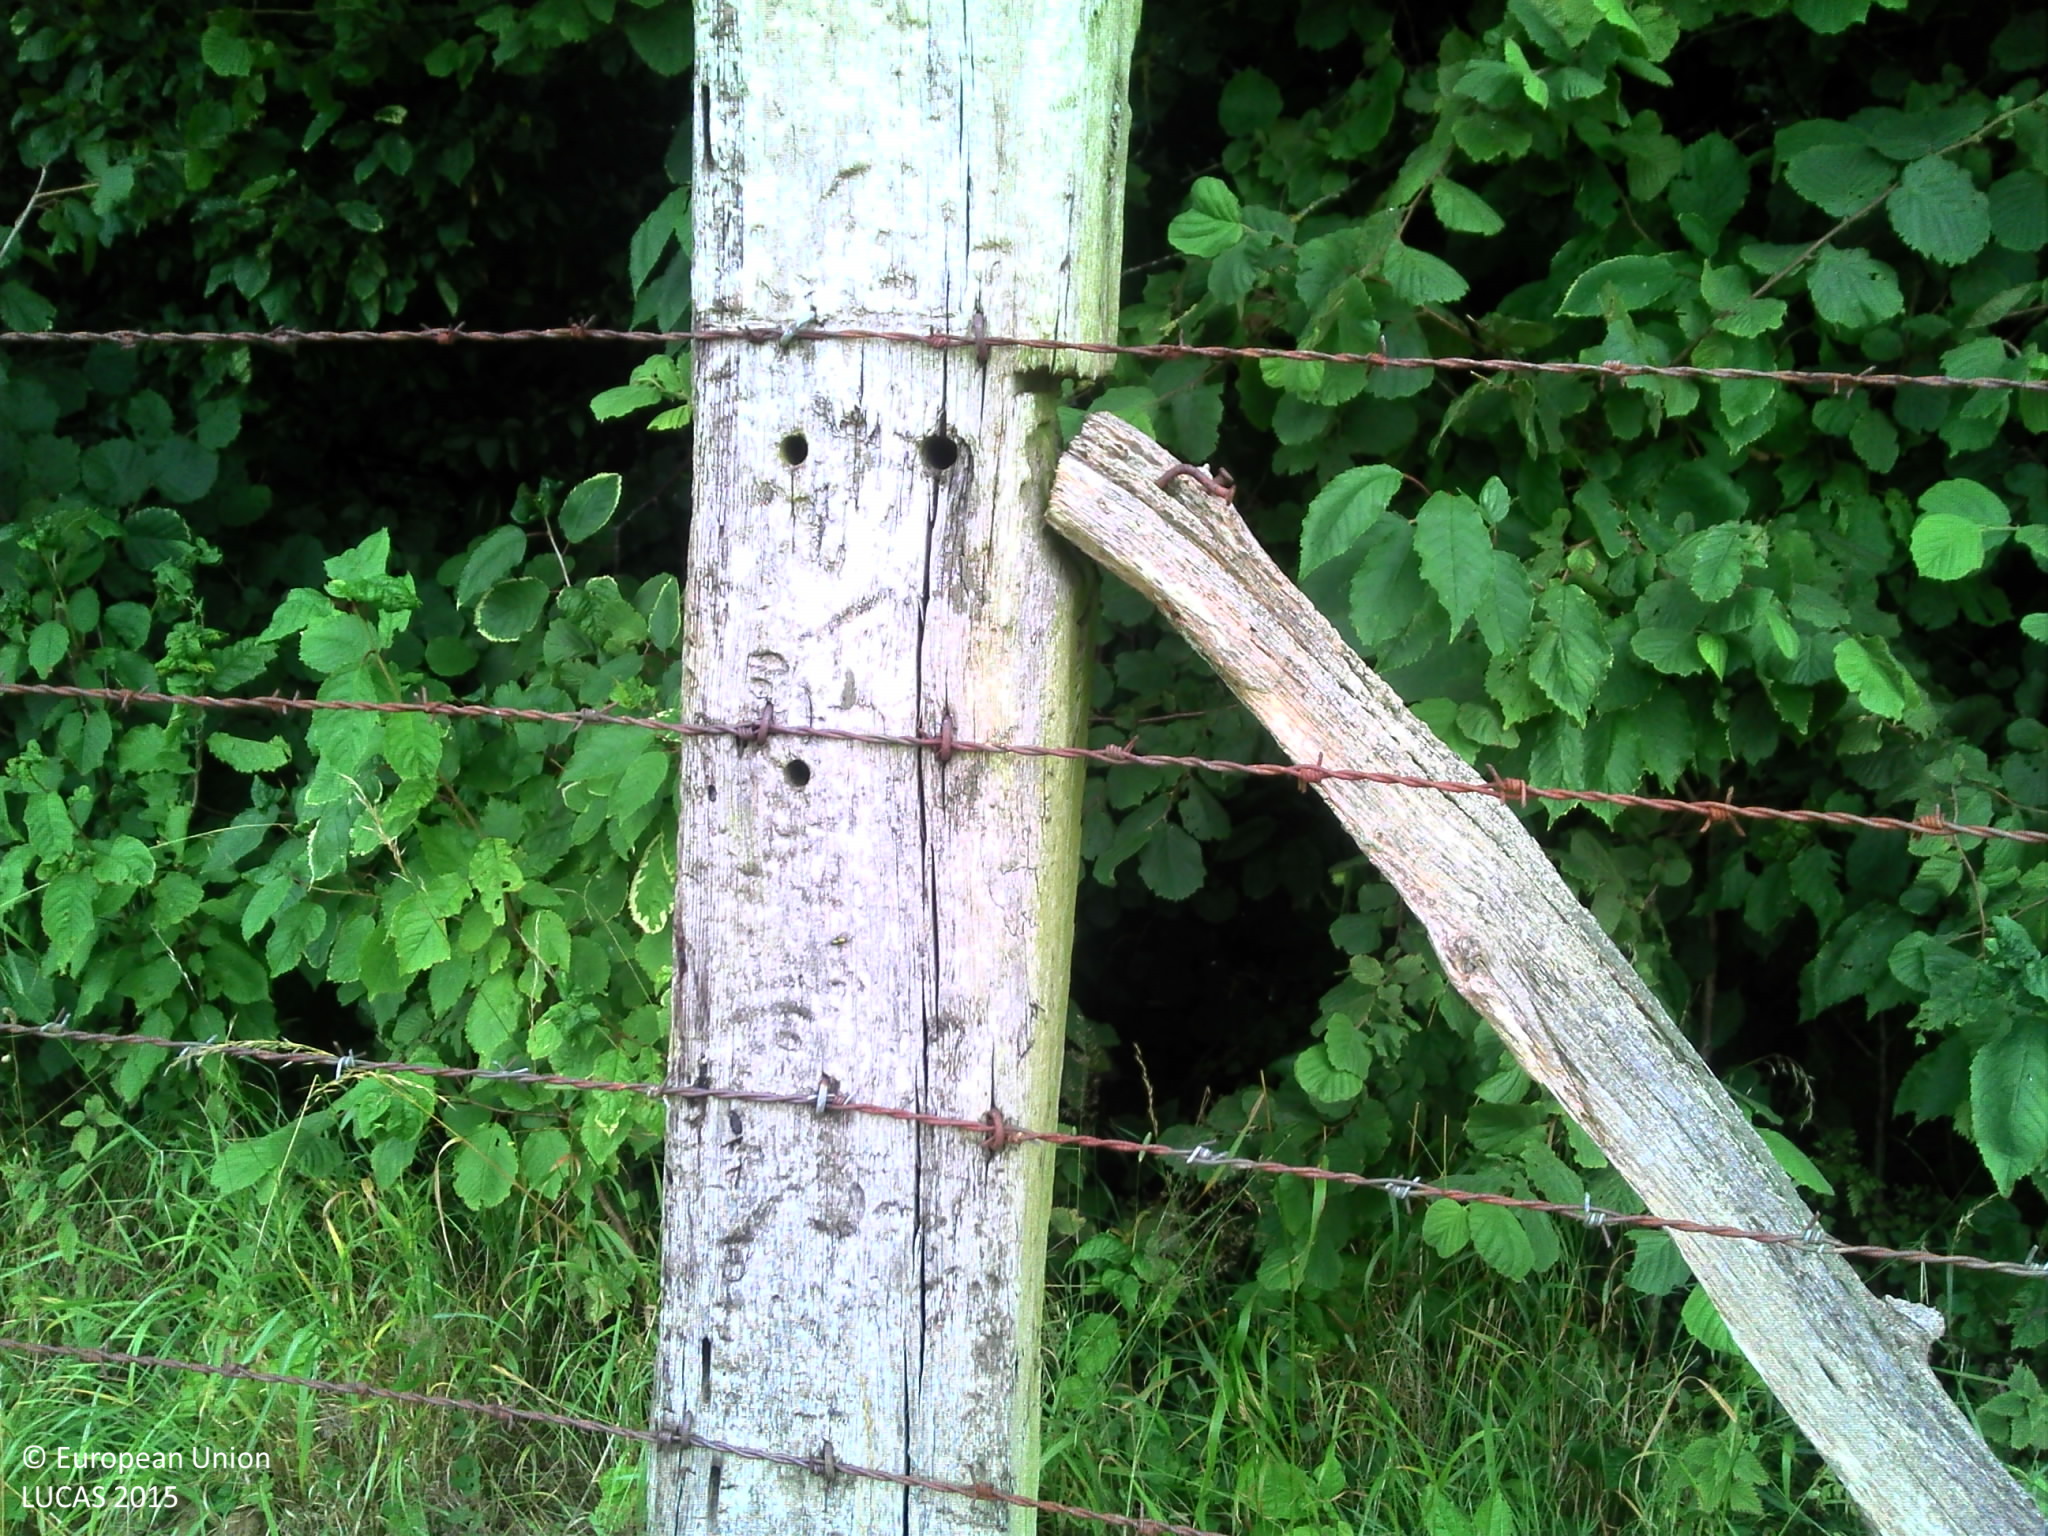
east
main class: Grassland
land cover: Grassland without tree/shrub cover
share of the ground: > 75 %
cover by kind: herbaceous plants 100 %
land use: Agriculture (excluding fallow land and kitchen gardens)
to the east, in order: Grassland without tree/shrub cover; Fences; Broadleaved woodland; Tracks; Barley; Common wheat
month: July
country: FR
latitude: 50.1332
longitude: 2.1933
